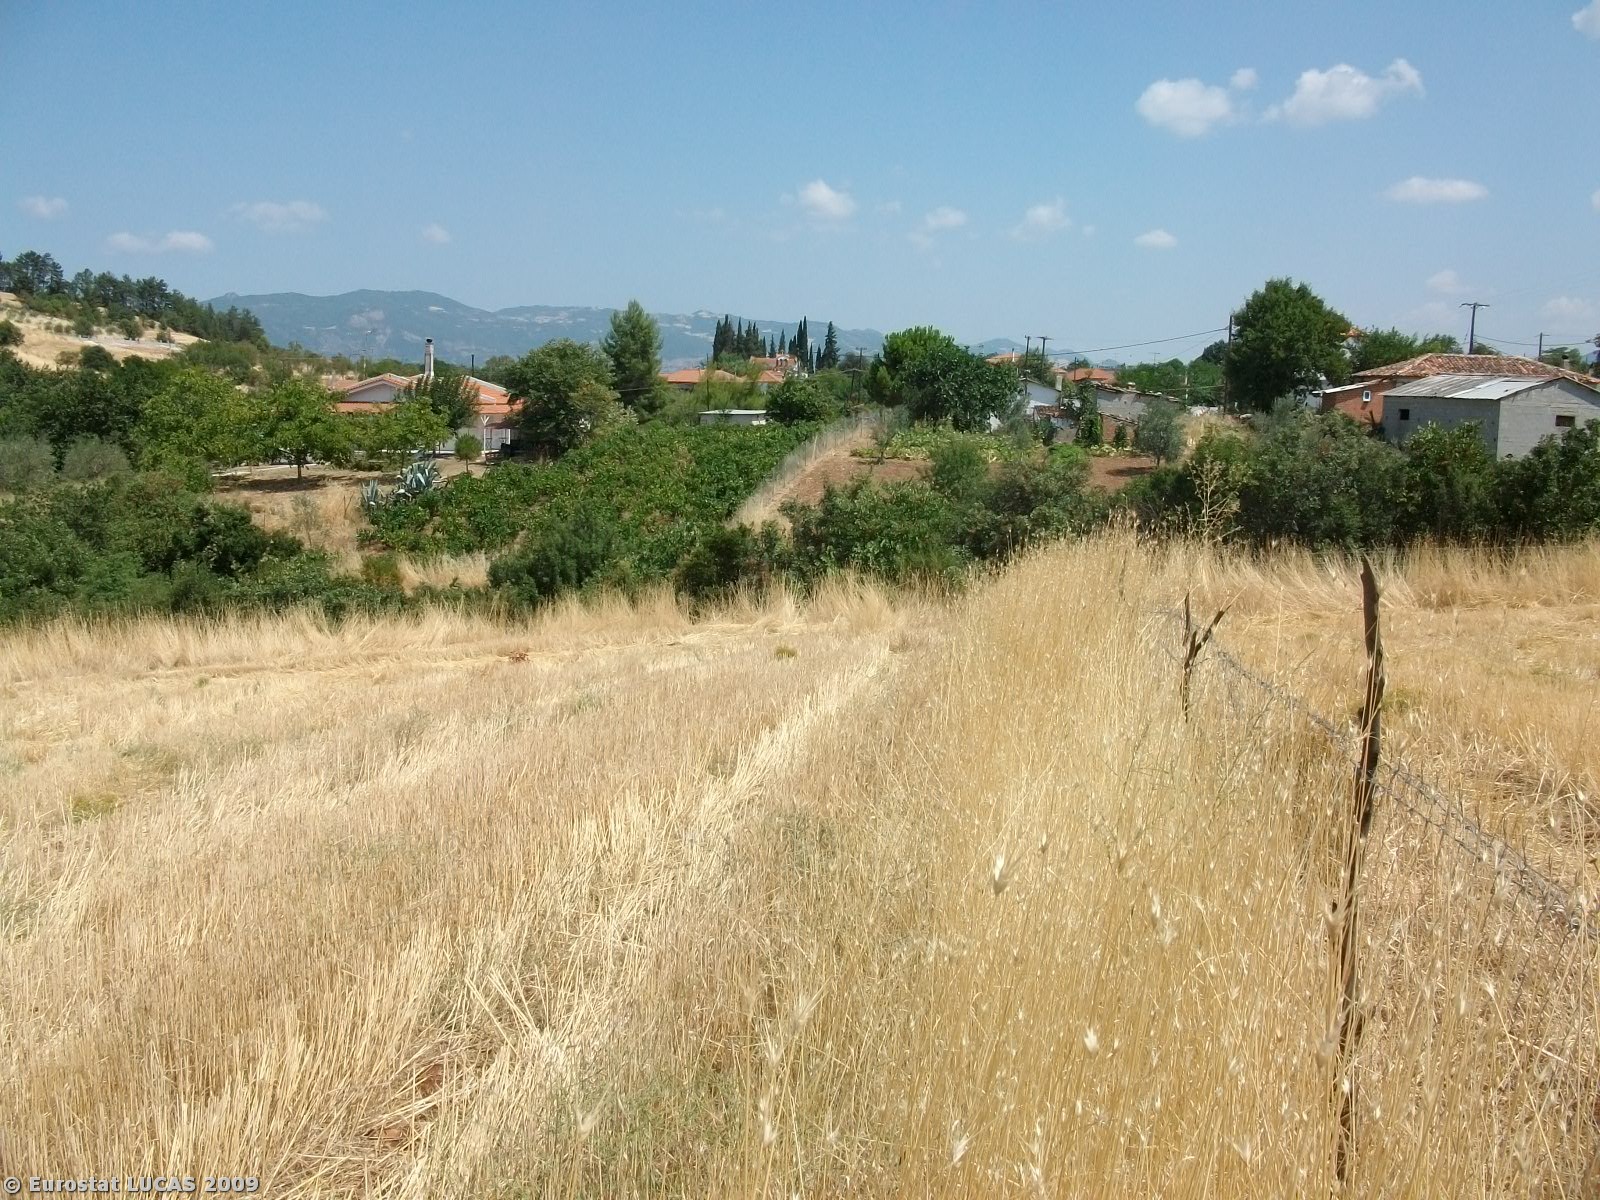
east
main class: Cropland
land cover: Durum wheat
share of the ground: < 10 %
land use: Agriculture (excluding fallow land and kitchen gardens)
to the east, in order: Durum wheat; Fences; Tracks; Shrubland without tree cover; Rivers and streams; Olive groves; Grassland with sparse tree/shrub cover; Artificial constructions in urban areas; Paved roads, cycling and walking lanes; Shrubland with sparse tree cover; Artificial constructions in urban areas
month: August
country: GR
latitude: 38.7288
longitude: 22.6682
